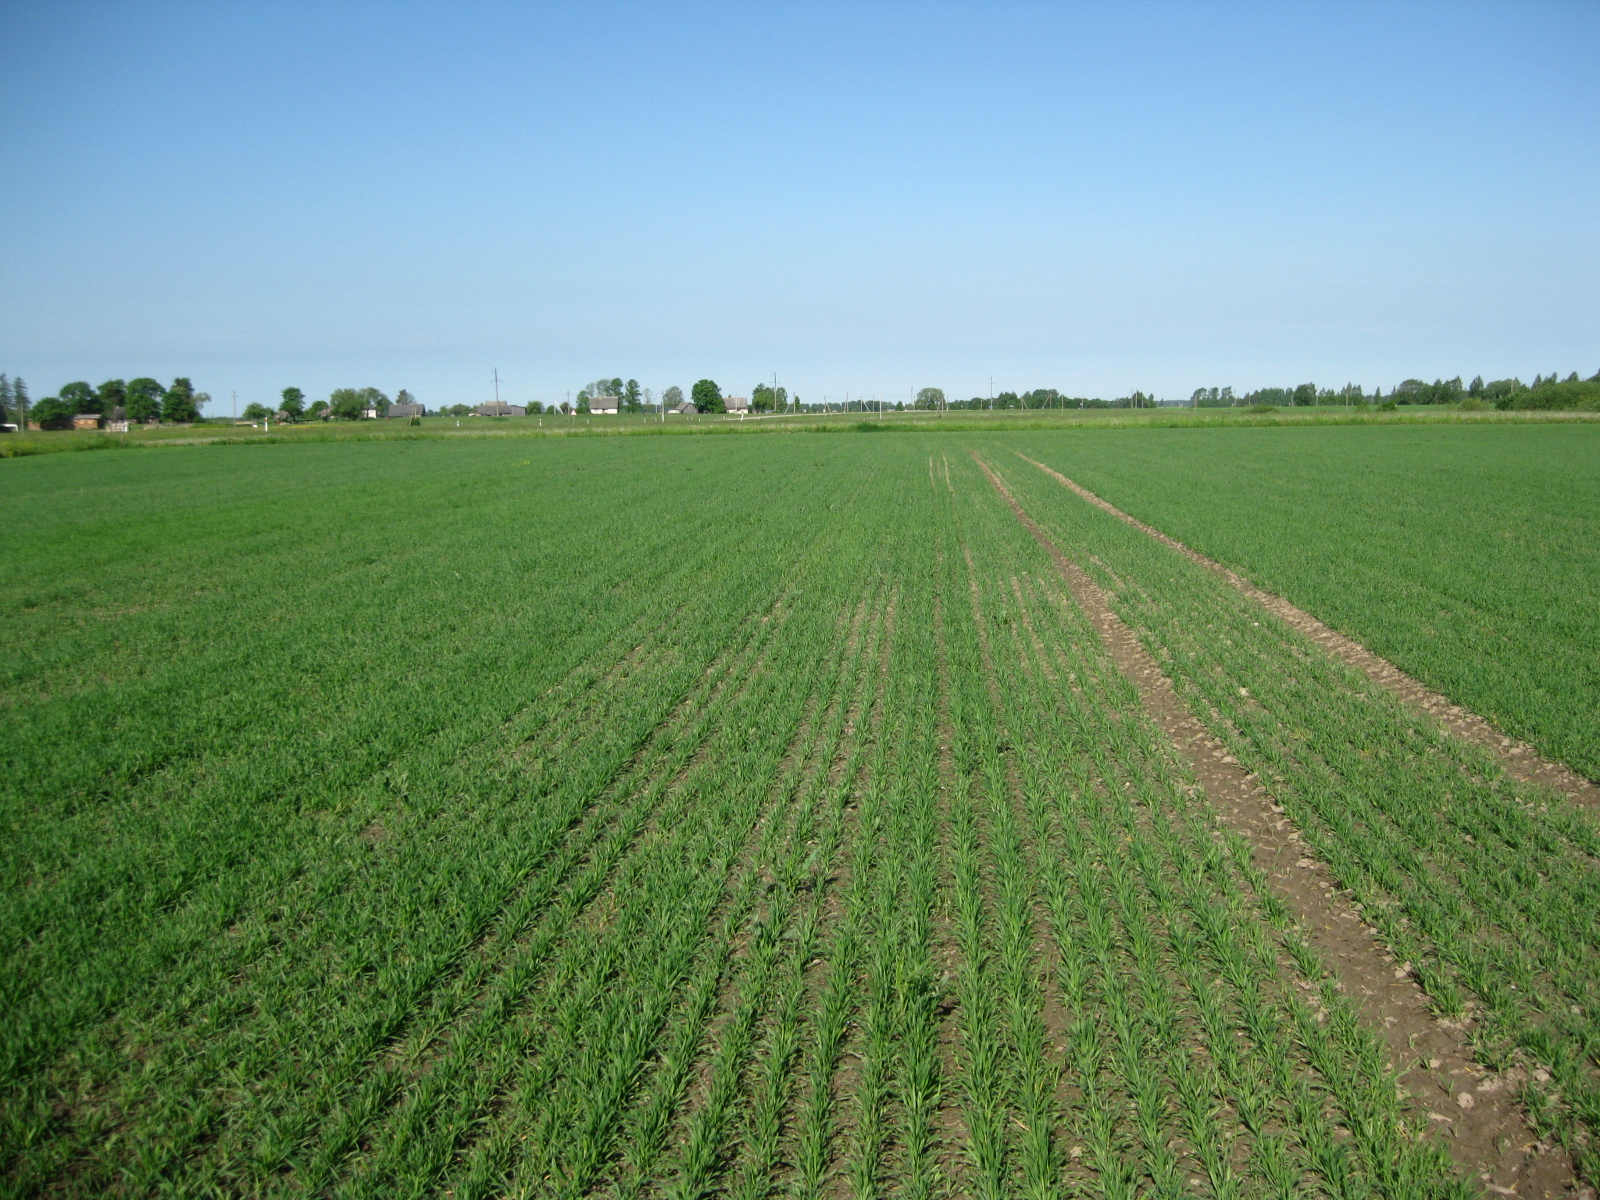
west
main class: Cropland
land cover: Barley
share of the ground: 50 - 75 %
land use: Agriculture (excluding fallow land and kitchen gardens)
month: May
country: LT
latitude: 55.8869
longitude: 24.8312
